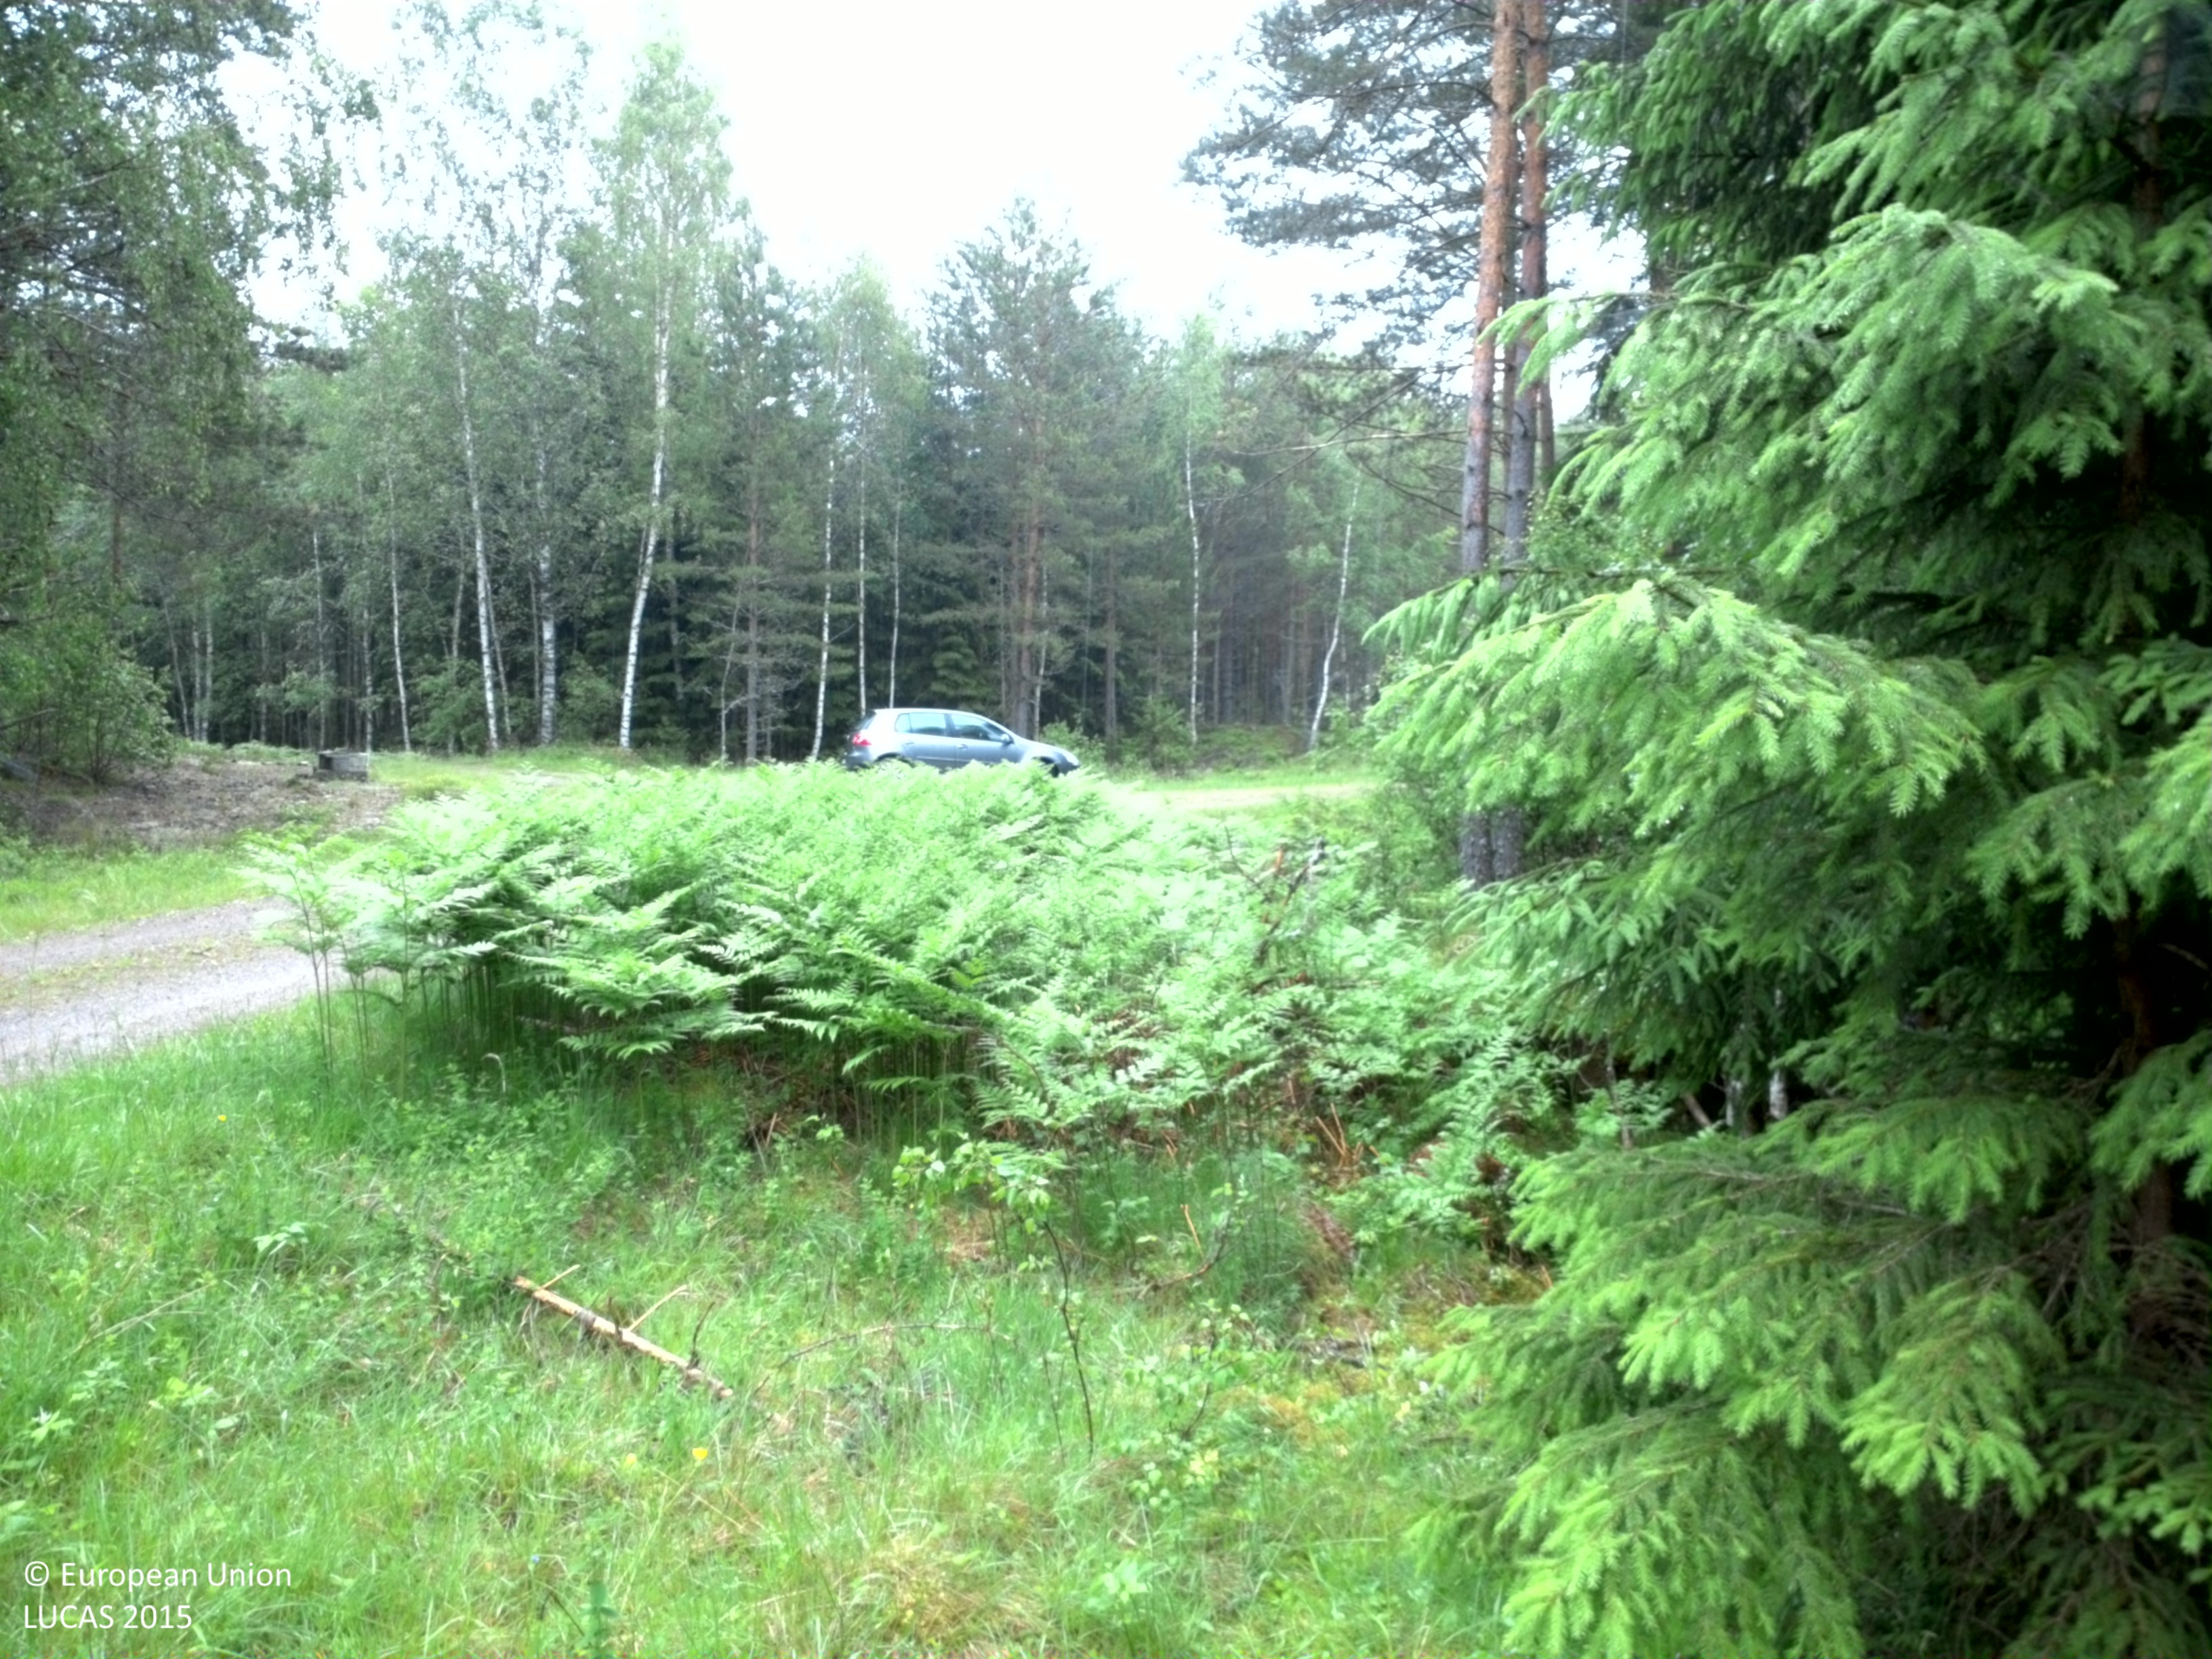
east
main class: Woodland
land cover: Pine dominated mixed woodland
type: boreal forest
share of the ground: 25 - 50 %
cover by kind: herbaceous plants 45 %, coniferous forest trees 30 %, broadleaved forest trees 15 %, lichens and mosses 10 %
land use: Forestry
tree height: > 5 m
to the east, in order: Pine dominated mixed woodland; Paved roads, cycling and walking lanes; Spruce dominated mixed woodland; Pine dominated coniferous woodland; Tracks; Spruce dominated coniferous woodland
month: June
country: SE
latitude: 58.6677
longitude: 15.4592
